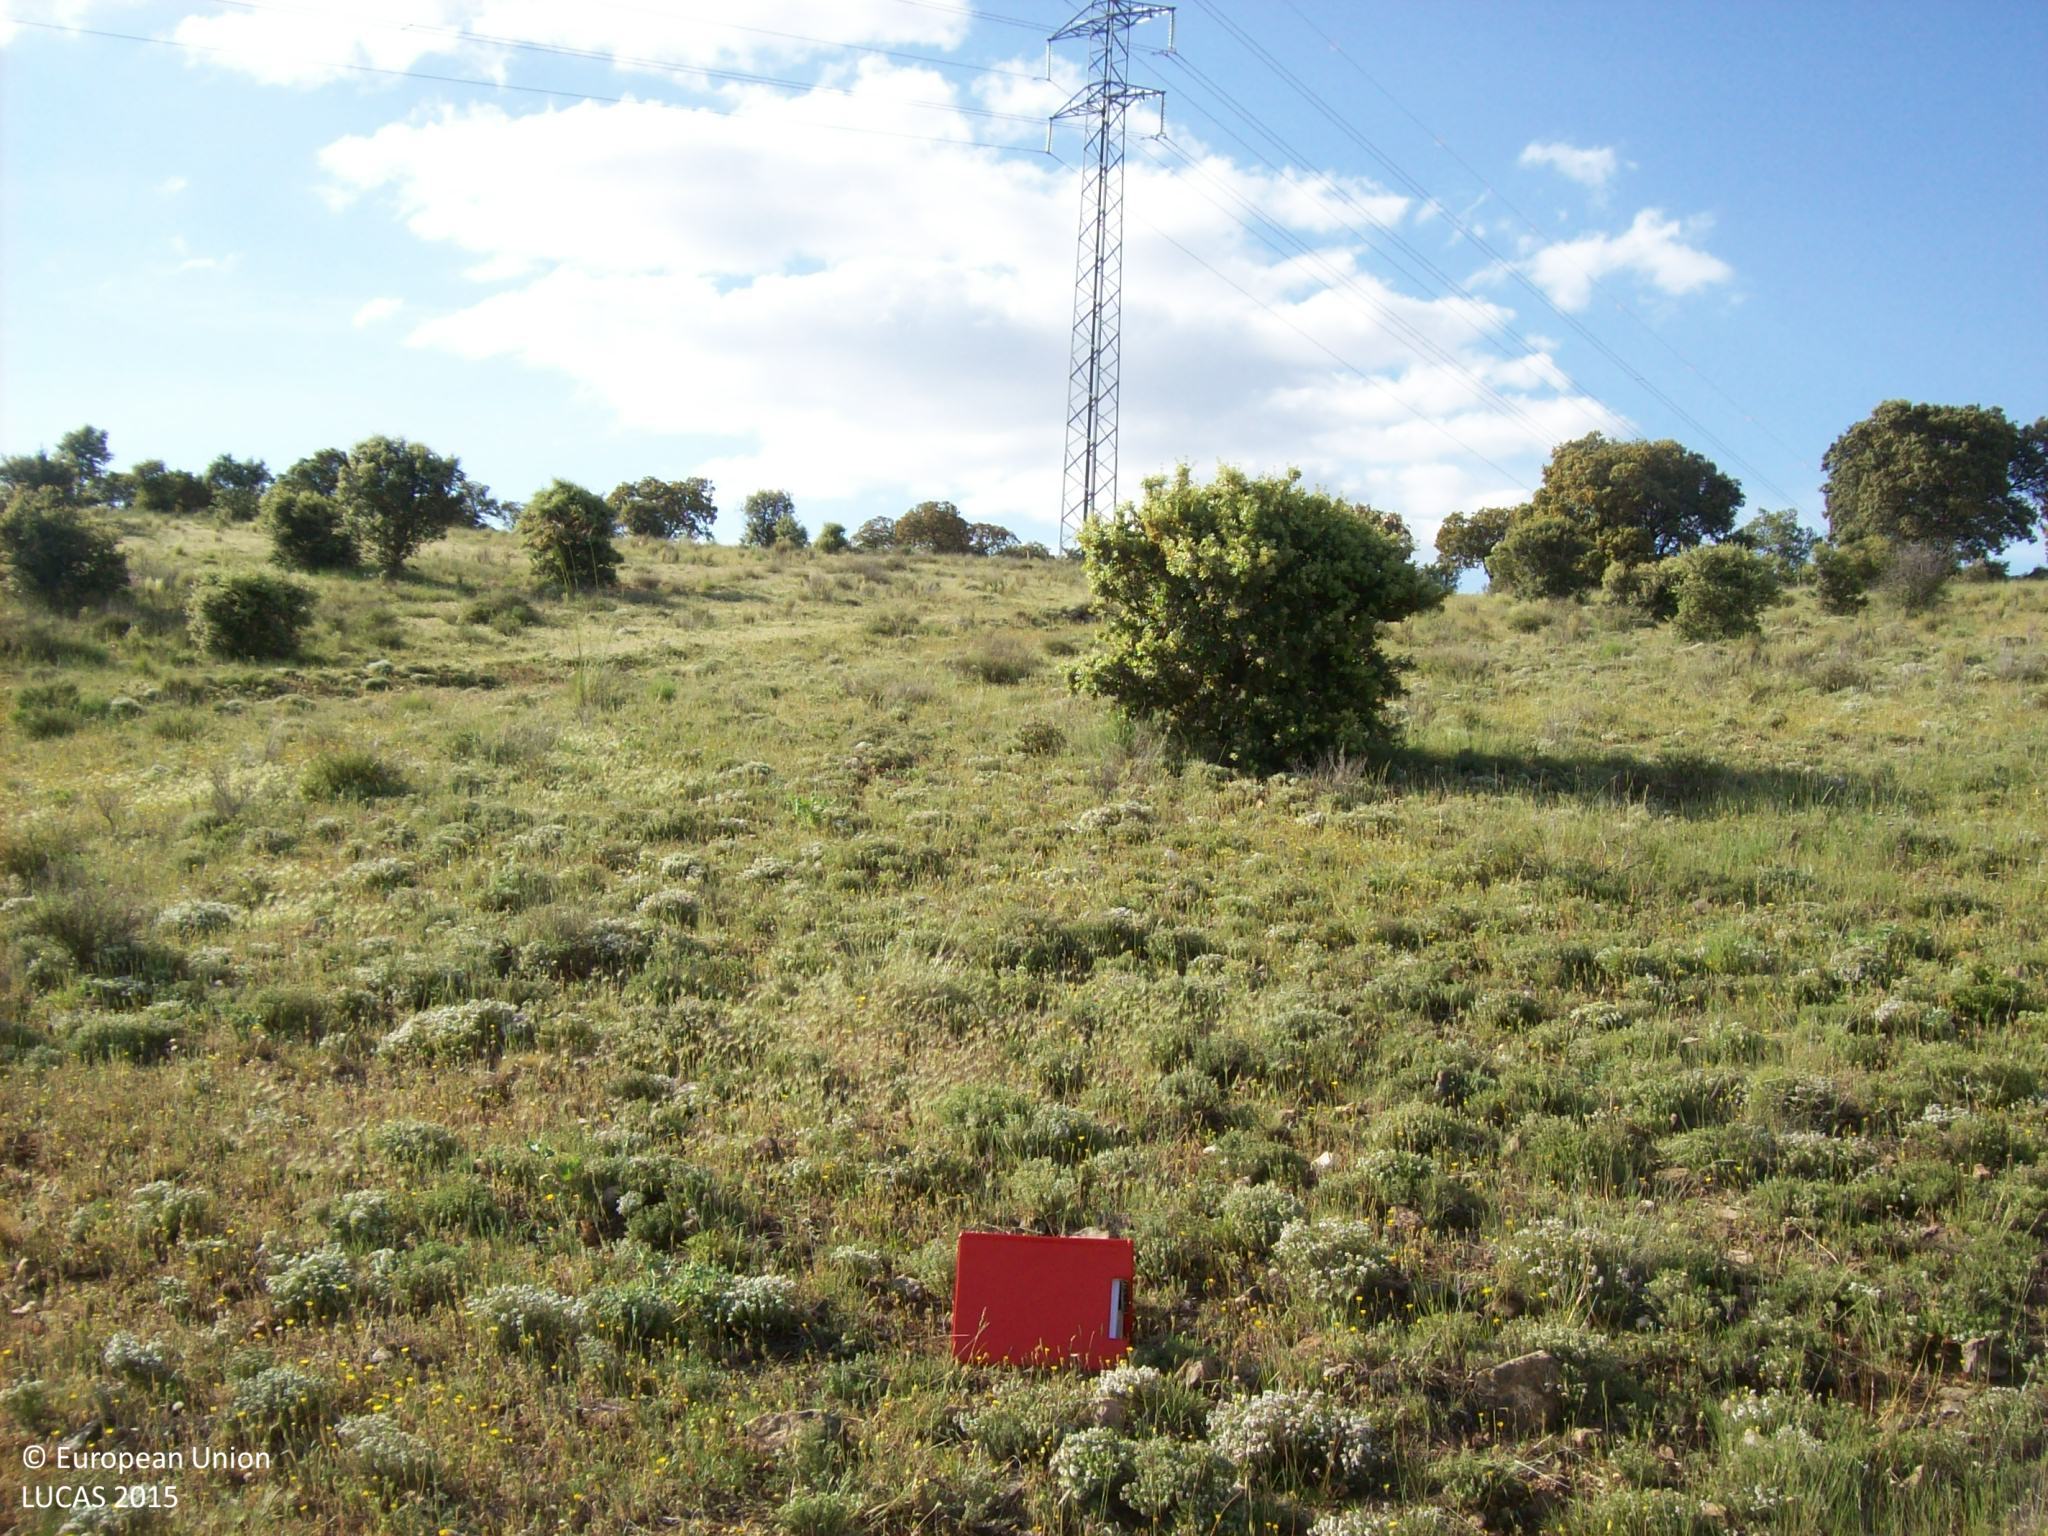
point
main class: Shrubland
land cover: Shrubland with sparse tree cover
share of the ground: 50 - 75 %
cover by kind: shrubs 60 %, lichens and mosses 20 %, herbaceous plants 15 %, broadleaved forest trees 5 %
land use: Semi-natural and natural areas not in use
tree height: < 5 m
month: May
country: ES
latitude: 40.7833
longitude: -4.4748
